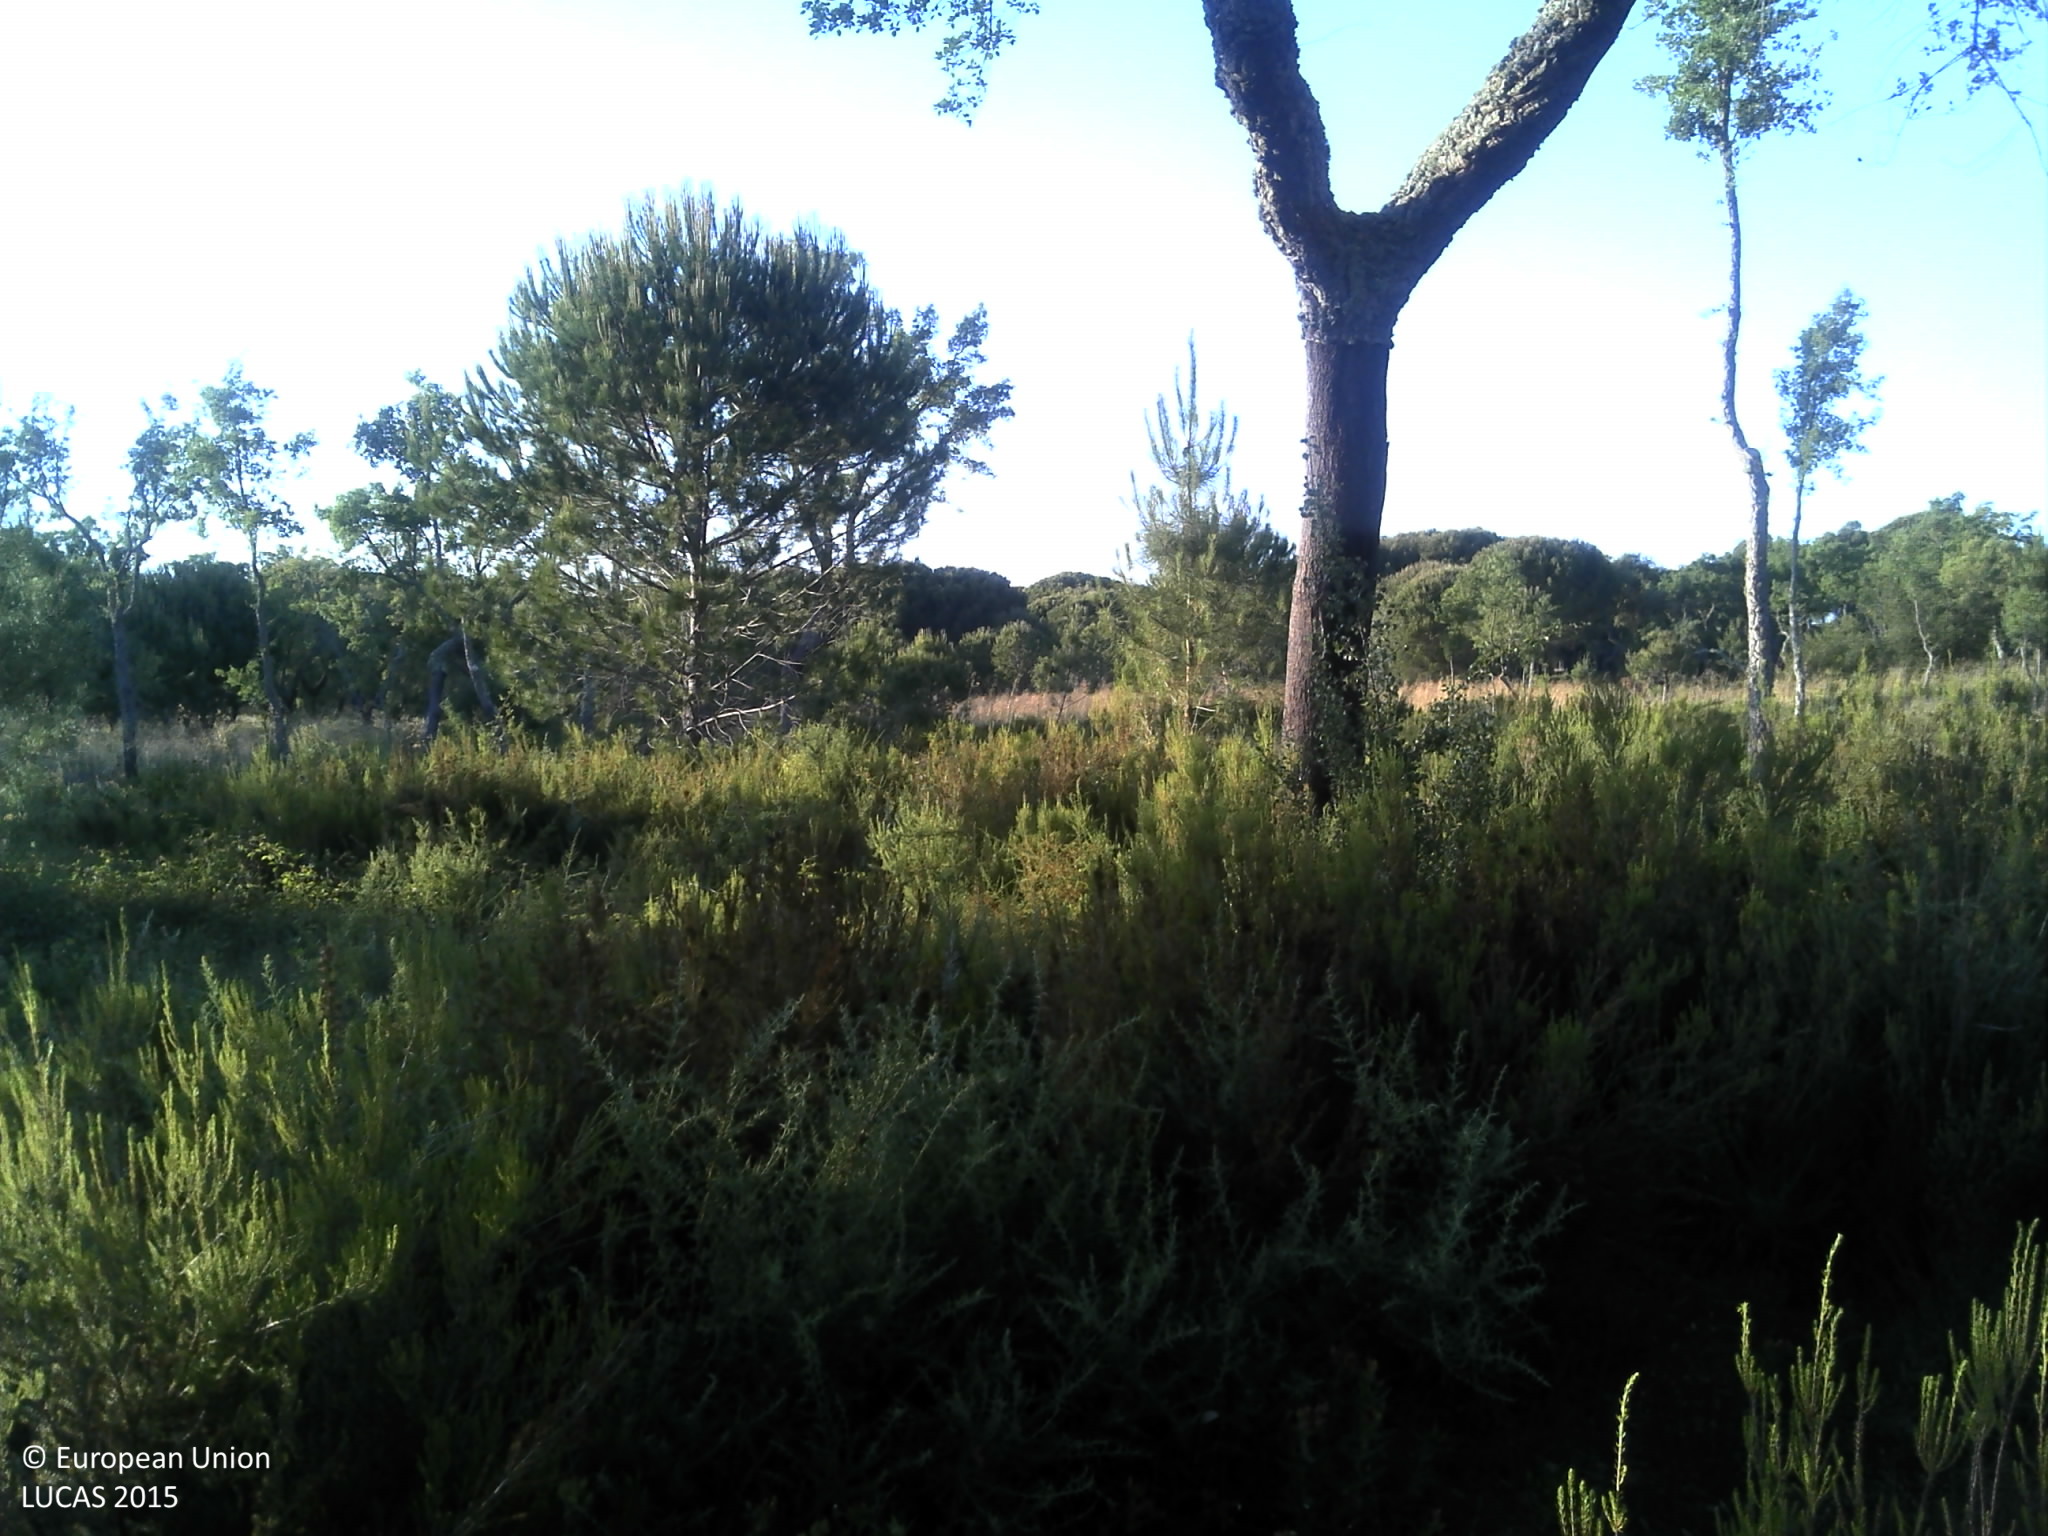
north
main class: Woodland
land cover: Broadleaved woodland
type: broadleaved evergreen forest
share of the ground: 25 - 50 %
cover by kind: broadleaved forest trees 60 %, shrubs 30 %, herbaceous plants 5 %, unconsolidated bare surface 5 %
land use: Forestry
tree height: > 5 m
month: May
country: PT
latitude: 38.2231
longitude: -8.6358
